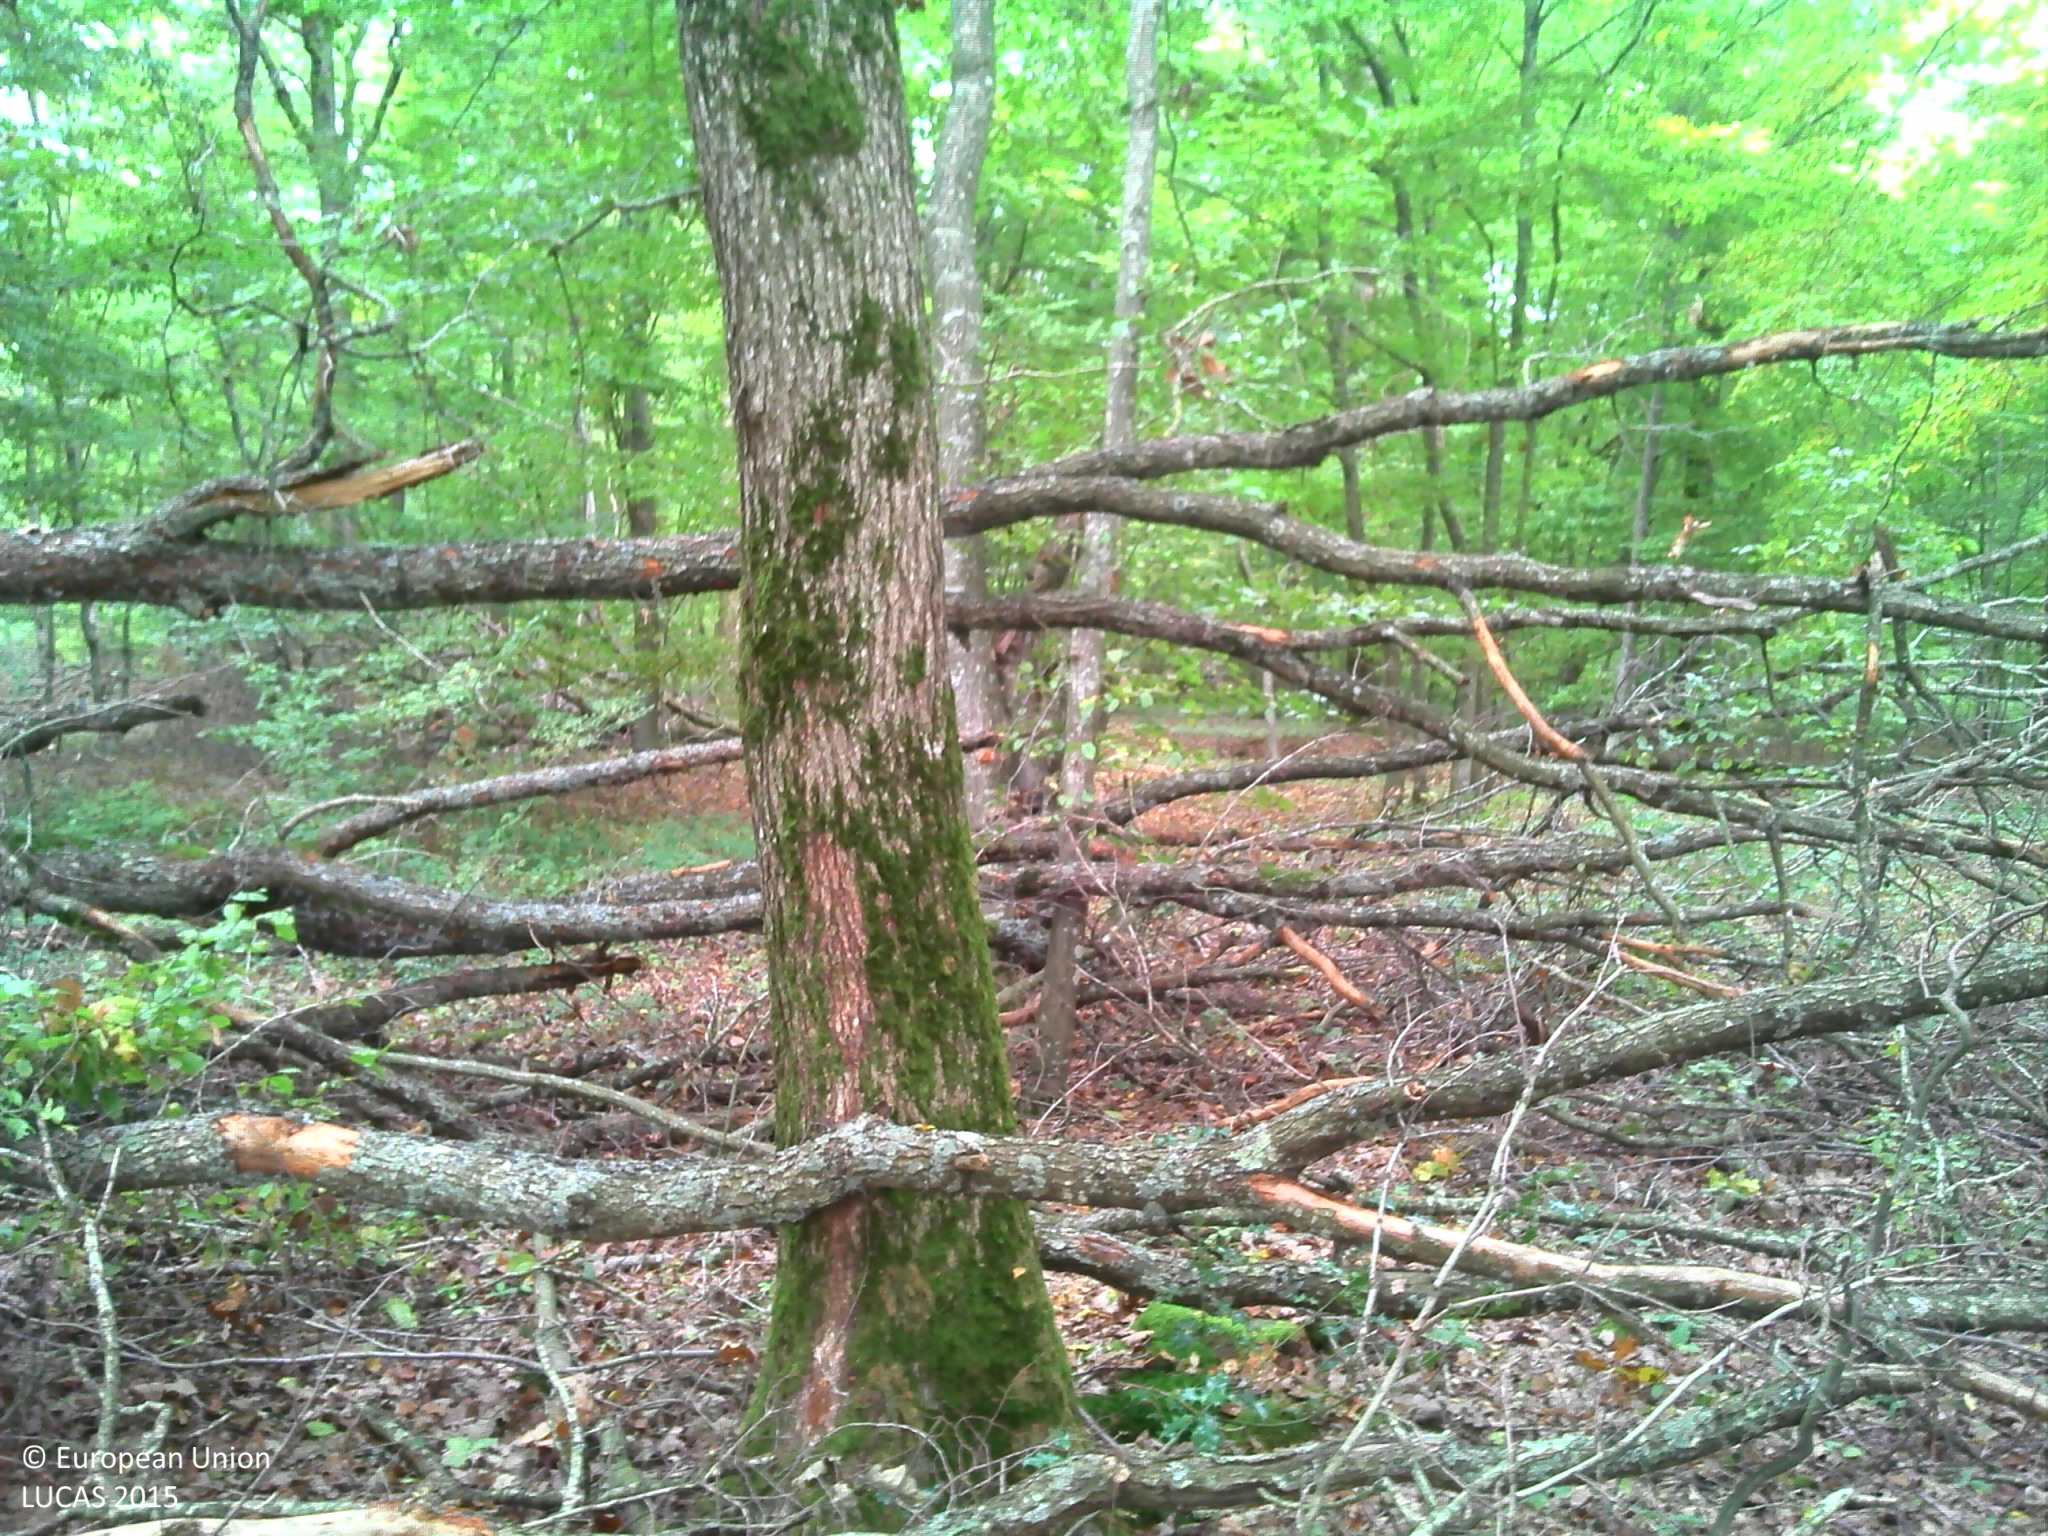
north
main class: Woodland
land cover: Broadleaved woodland
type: mesophytic deciduous forest
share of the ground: > 75 %
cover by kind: broadleaved forest trees 90 %, unconsolidated bare surface 10 %
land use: Forestry
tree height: > 5 m
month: October
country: FR
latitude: 47.8480
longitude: 1.3646
